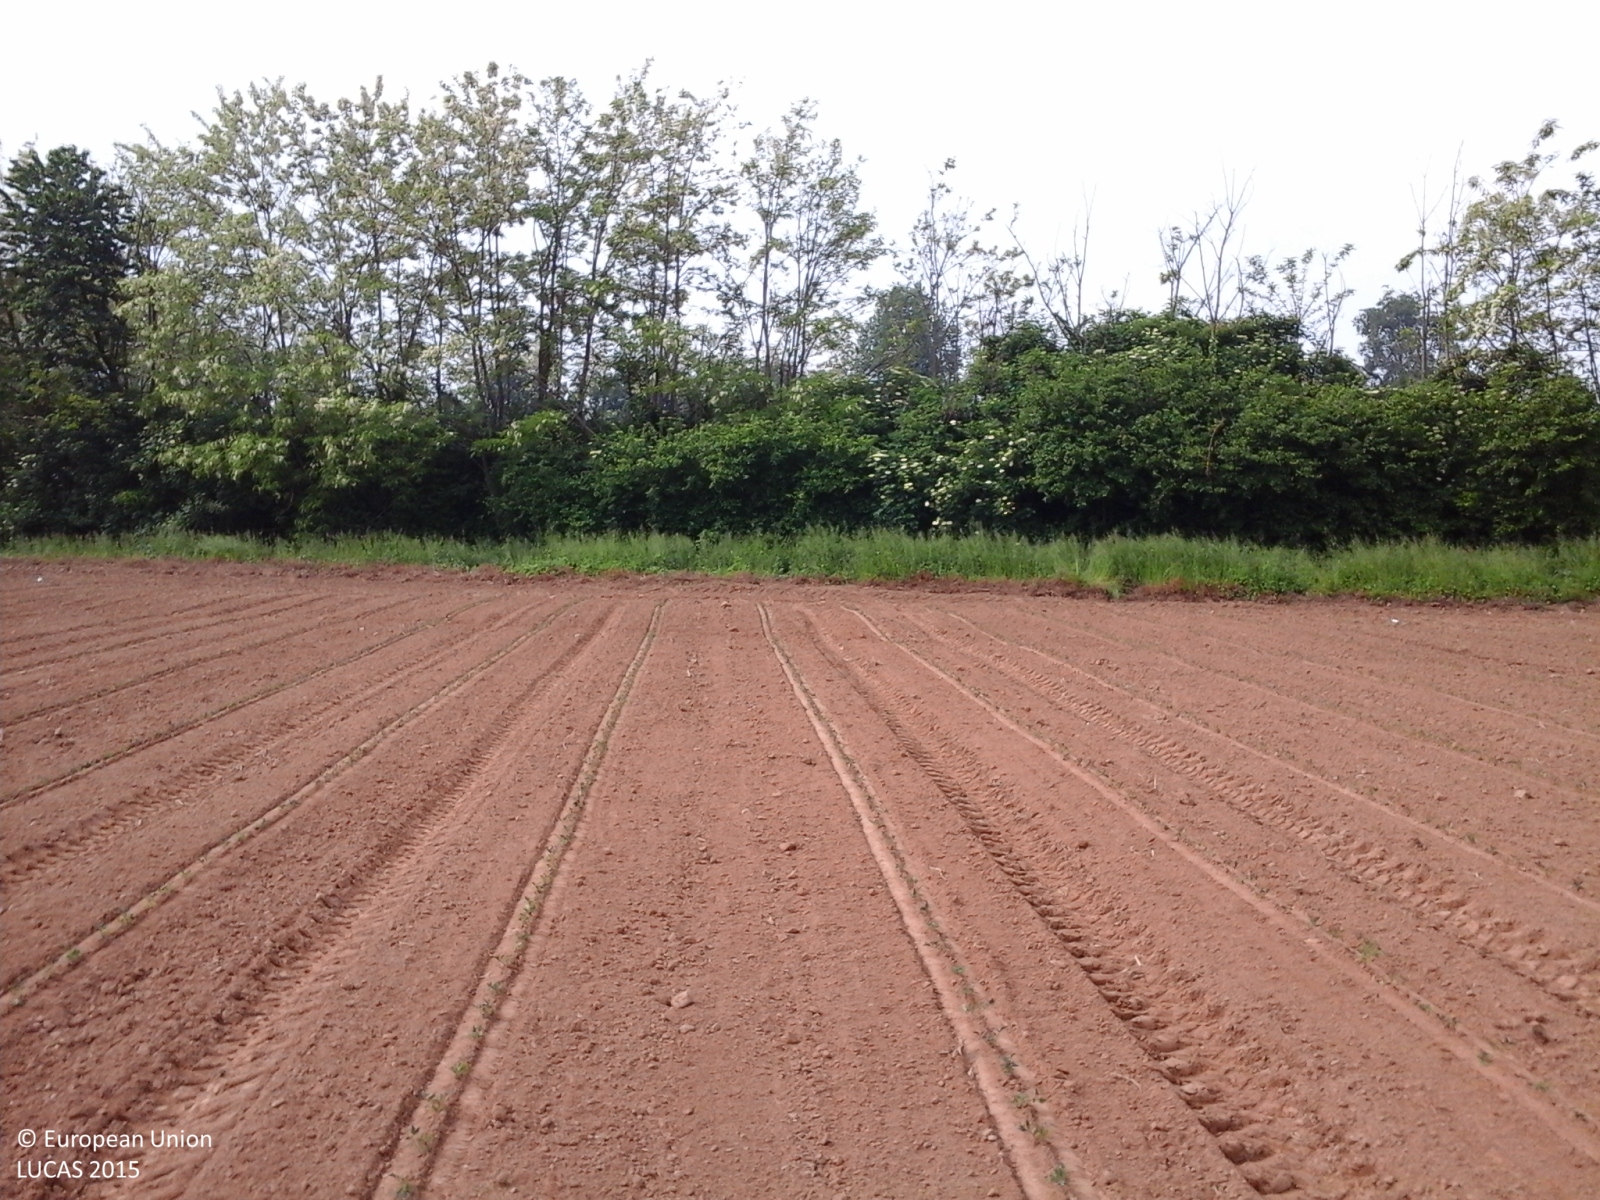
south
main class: Cropland
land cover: Tomatoes
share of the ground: 10 - 25 %
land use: Agriculture (excluding fallow land and kitchen gardens)
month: May
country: IT
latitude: 44.9451
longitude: 9.6585
